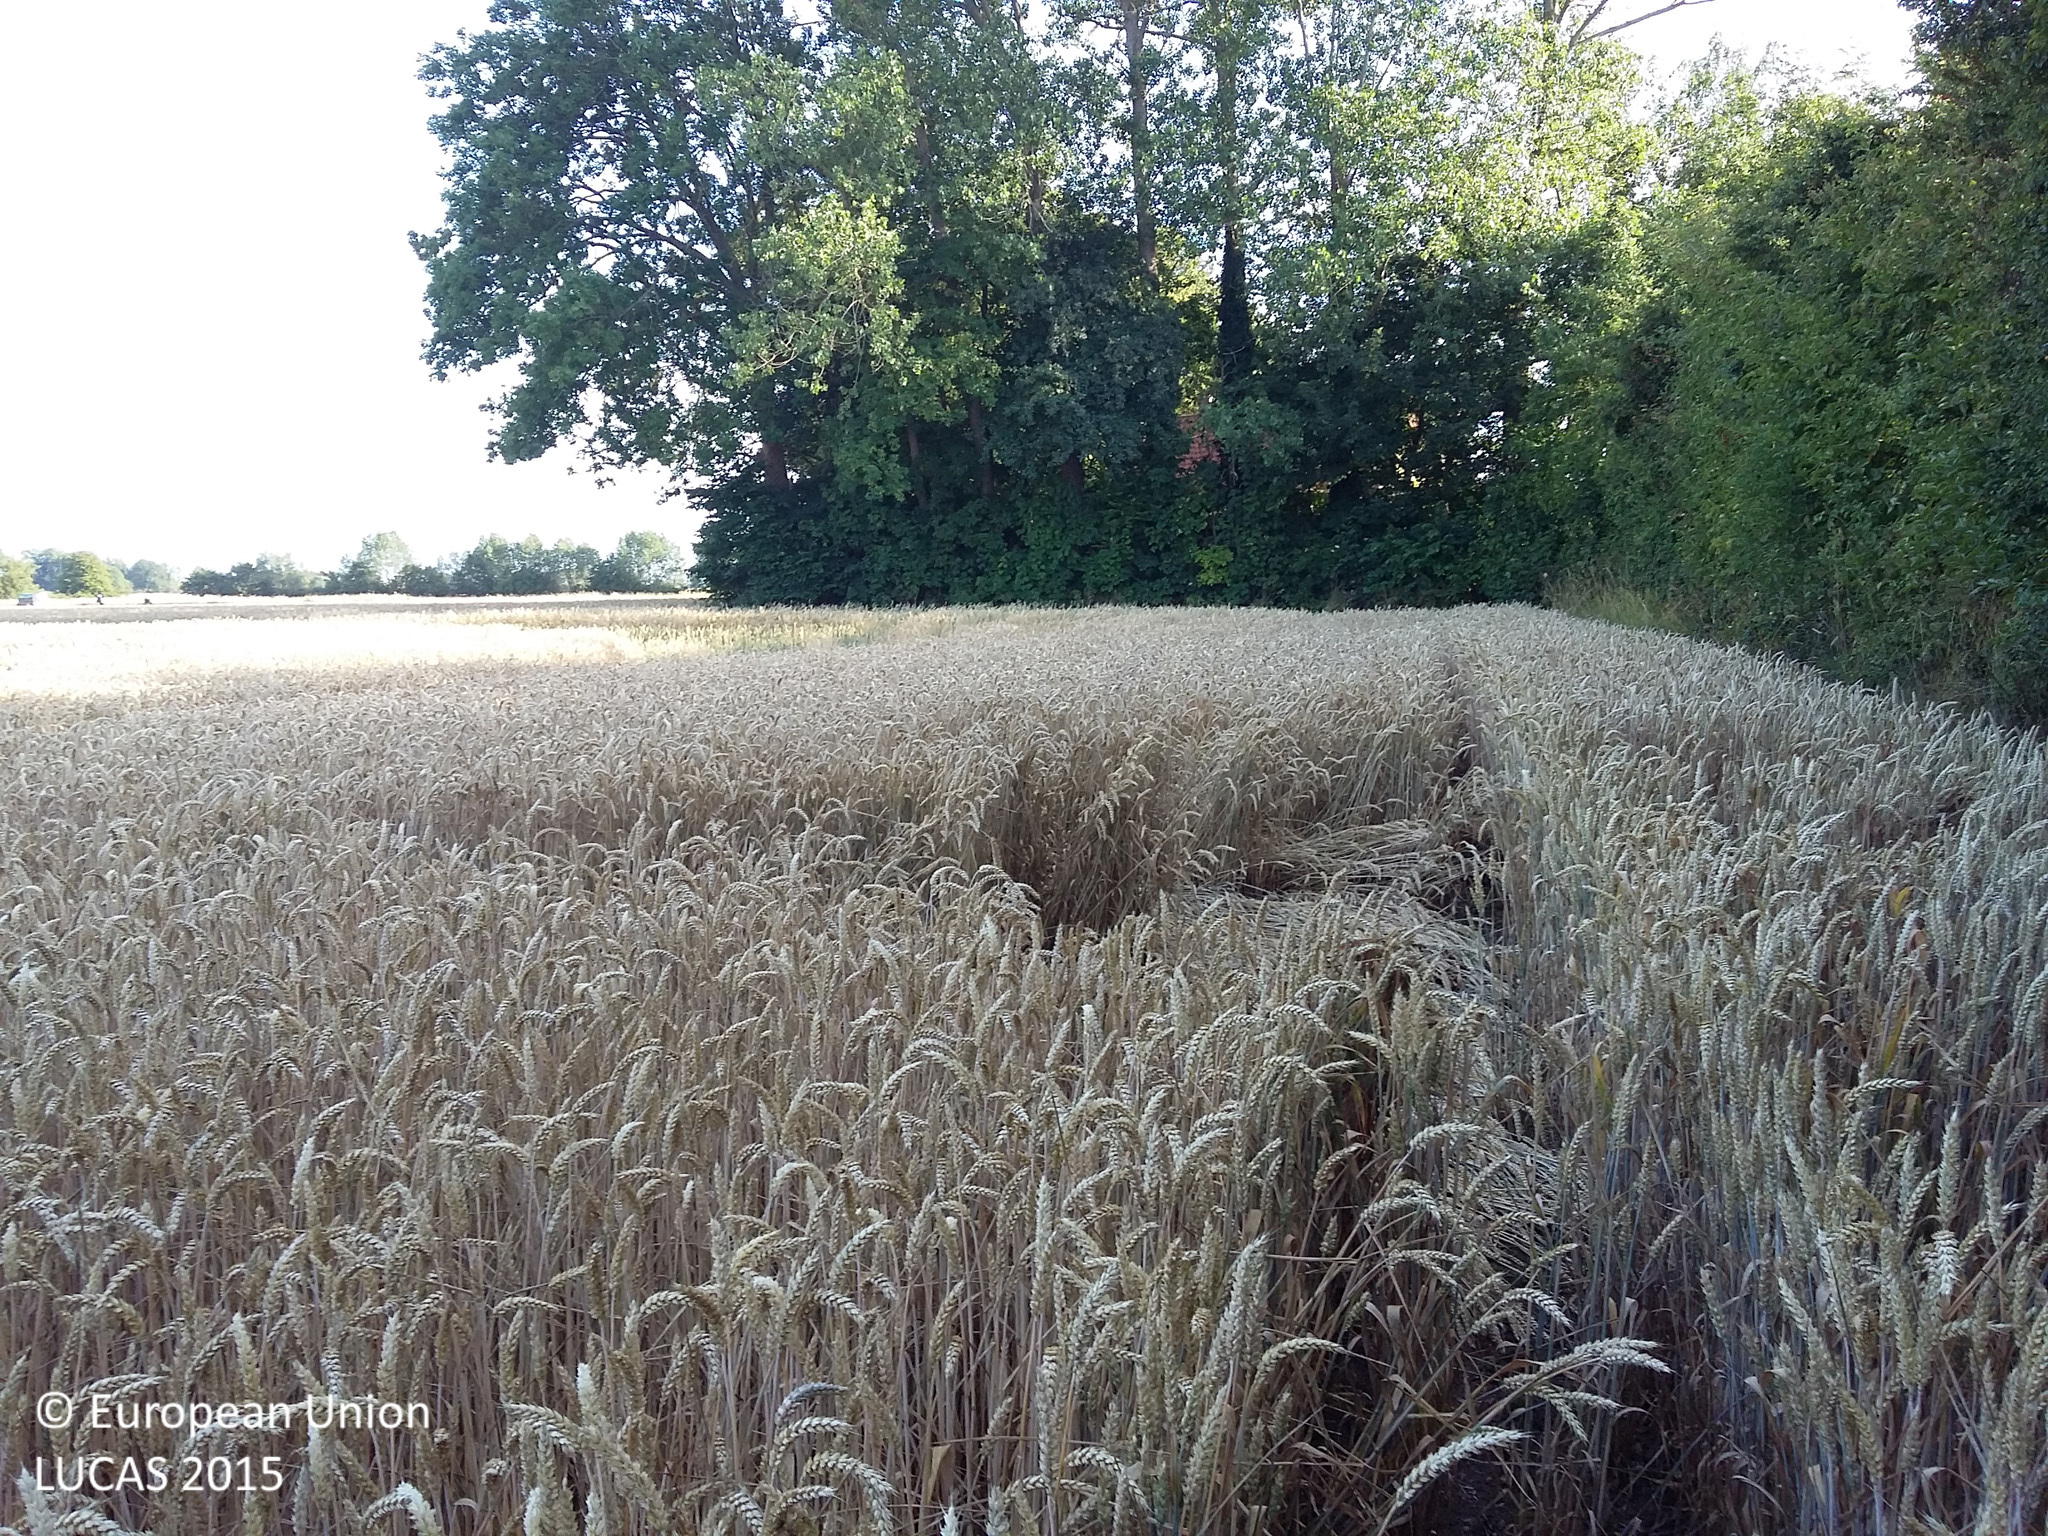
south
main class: Cropland
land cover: Common wheat
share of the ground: > 75 %
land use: Agriculture (excluding fallow land and kitchen gardens)
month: August
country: DK
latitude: 55.3576
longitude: 12.3171
